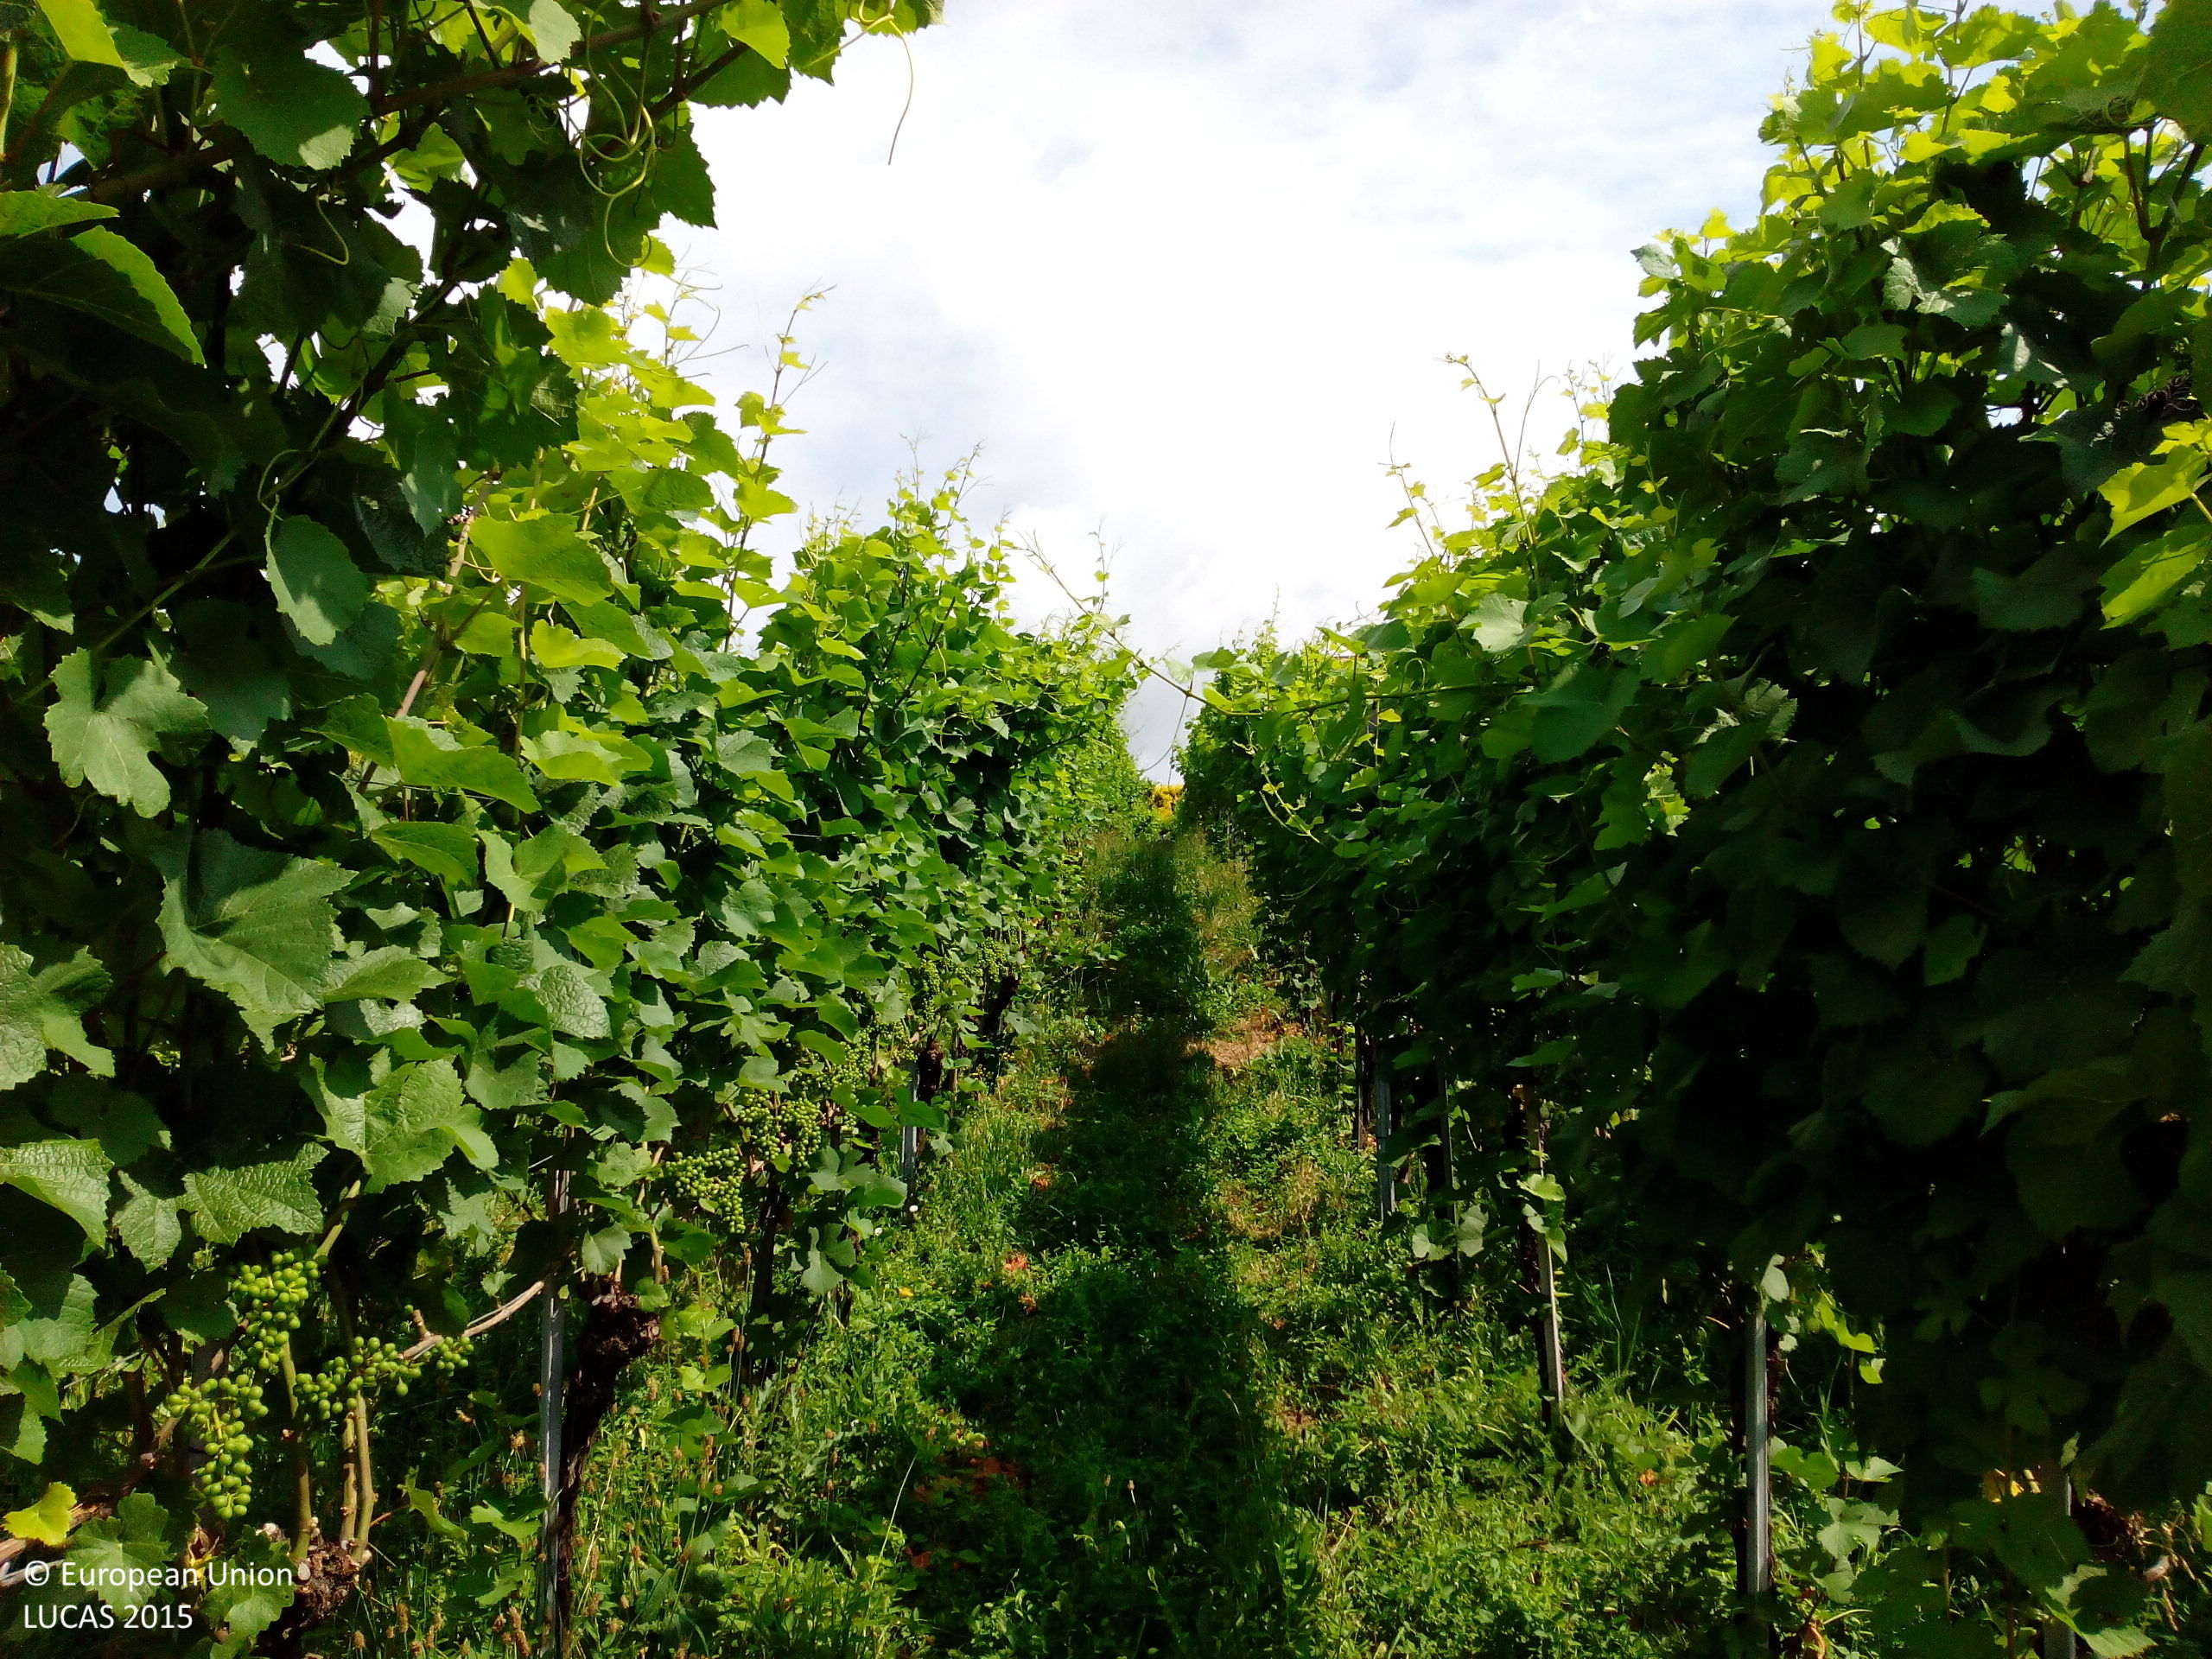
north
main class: Cropland
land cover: Vineyards
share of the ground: 25 - 50 %
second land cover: Grassland without tree/shrub cover
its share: 50 - 75 %
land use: Agriculture (excluding fallow land and kitchen gardens)
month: July
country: DE
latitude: 47.6217
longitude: 7.6198
